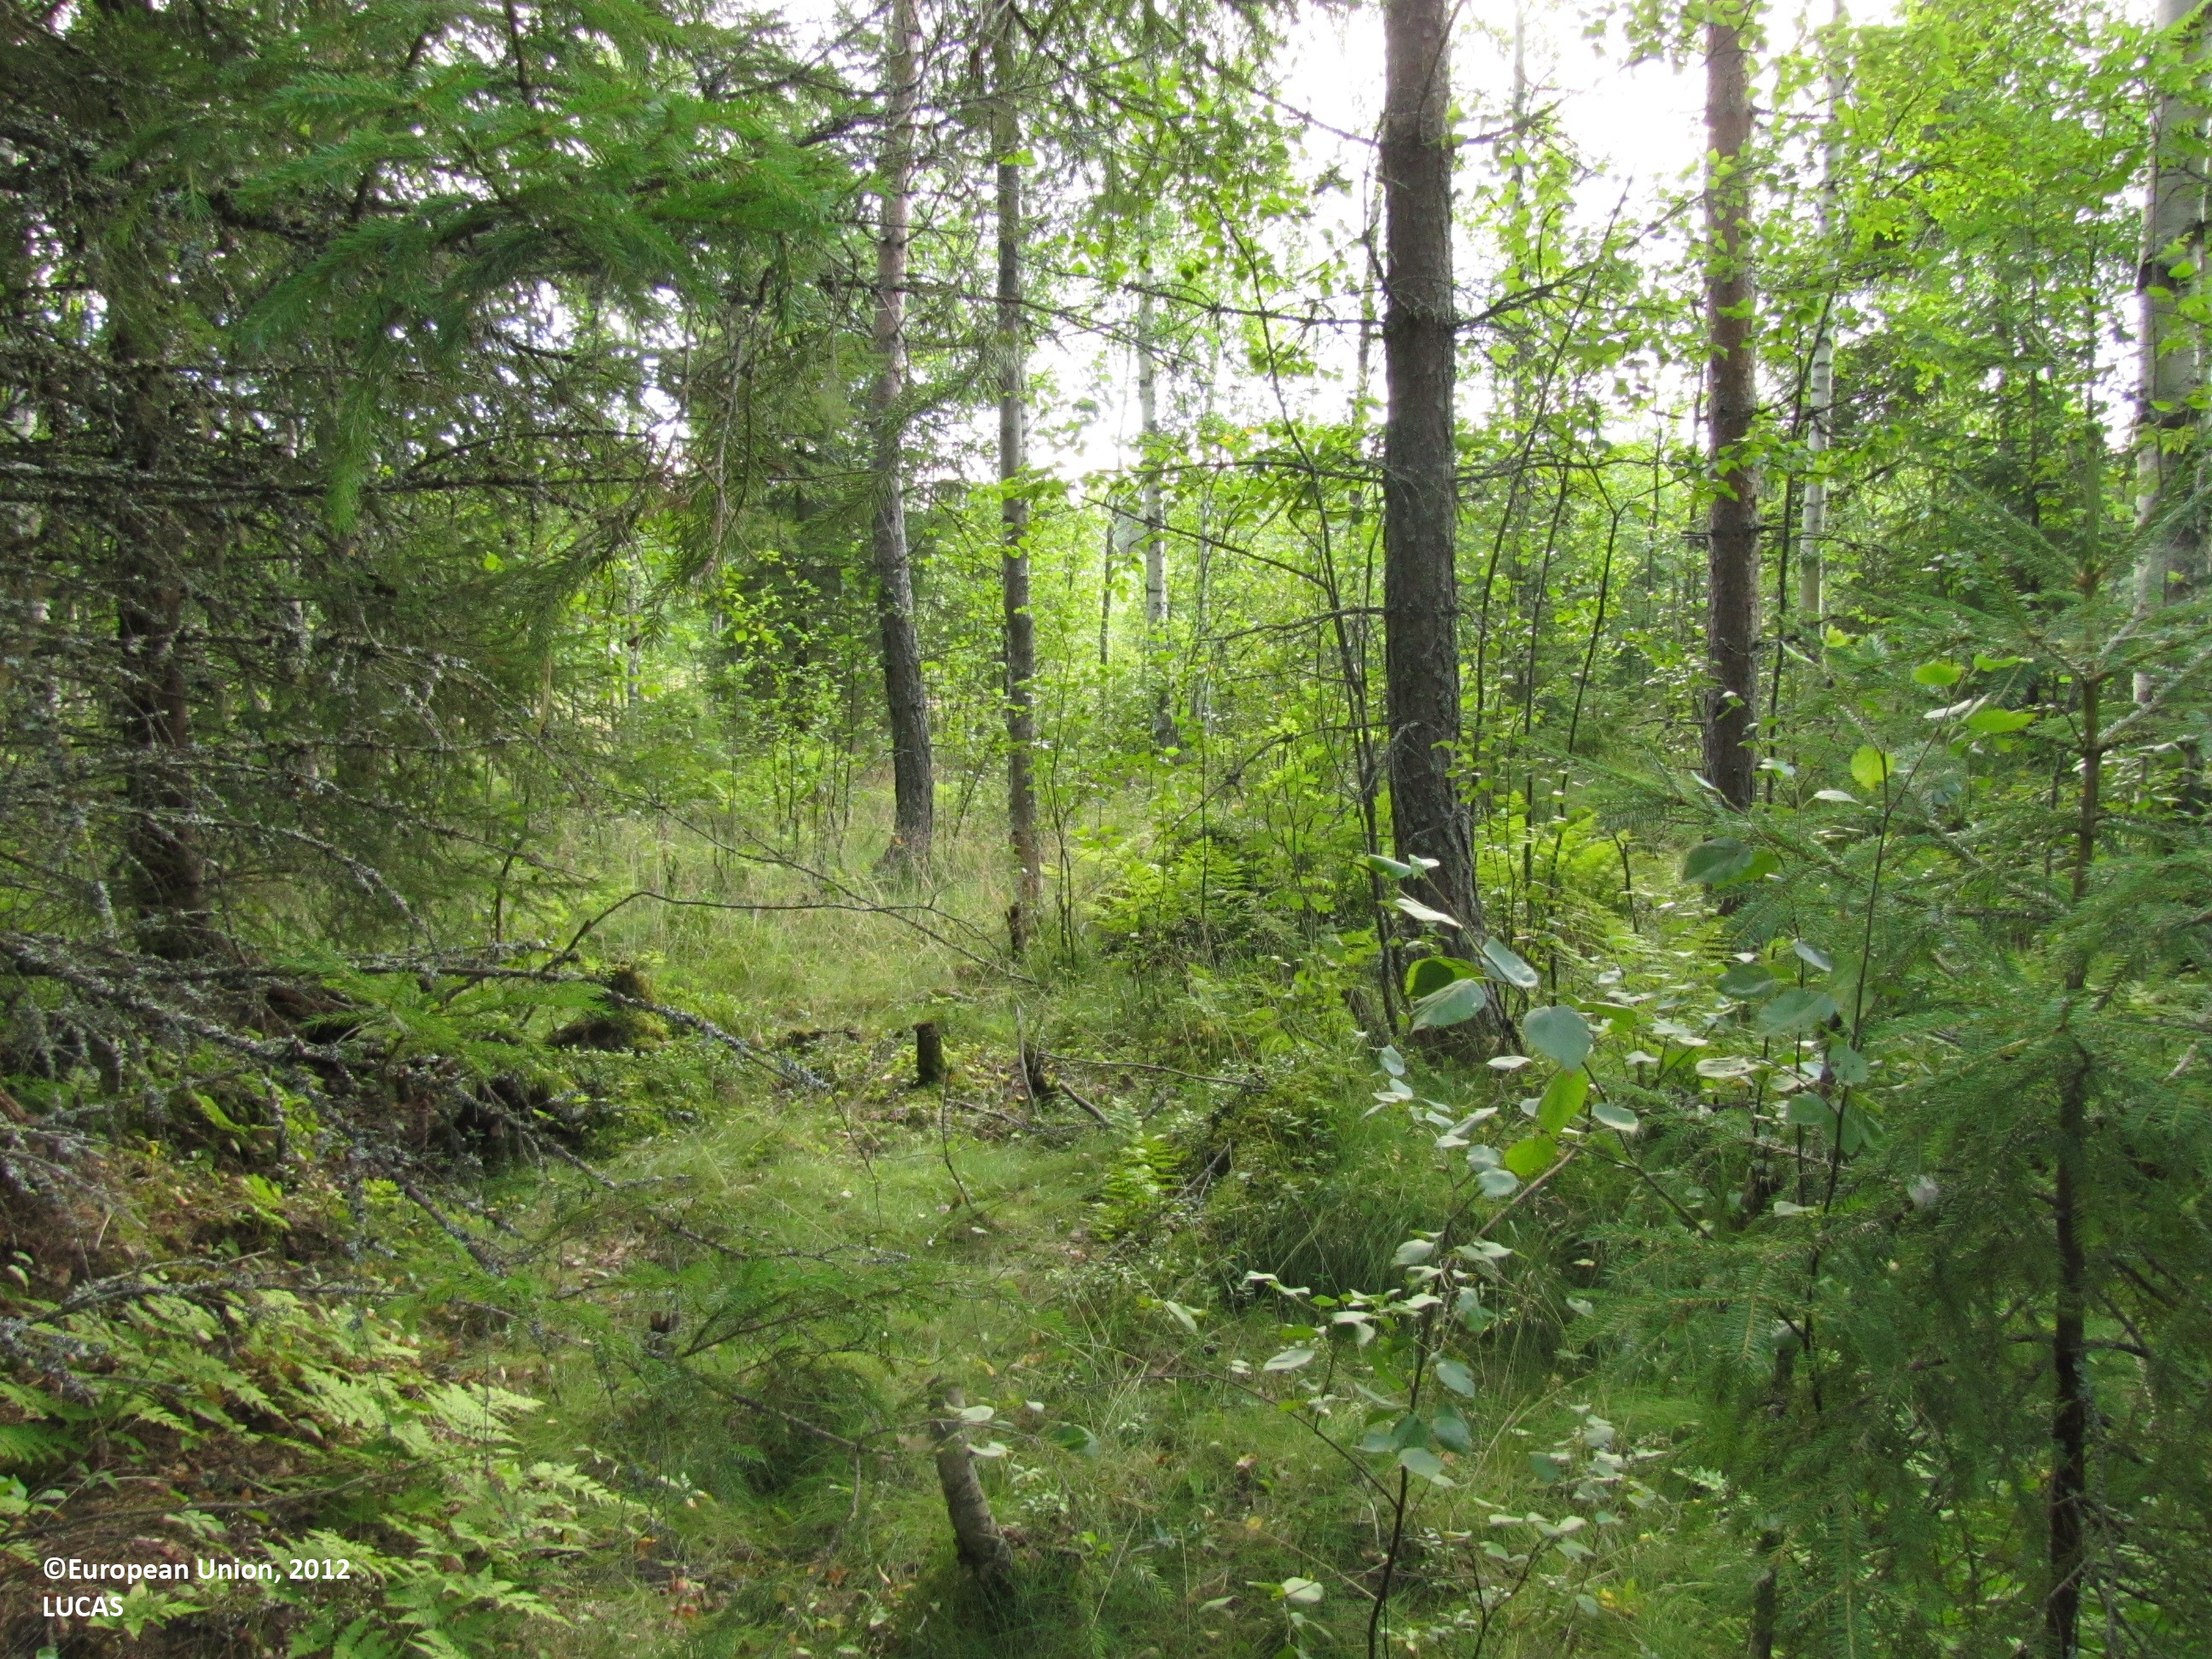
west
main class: Woodland
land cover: Spruce dominated mixed woodland
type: boreal forest
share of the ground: 50 - 75 %
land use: Forestry
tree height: > 5 m
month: August
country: FI
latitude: 61.7104
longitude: 23.0647
